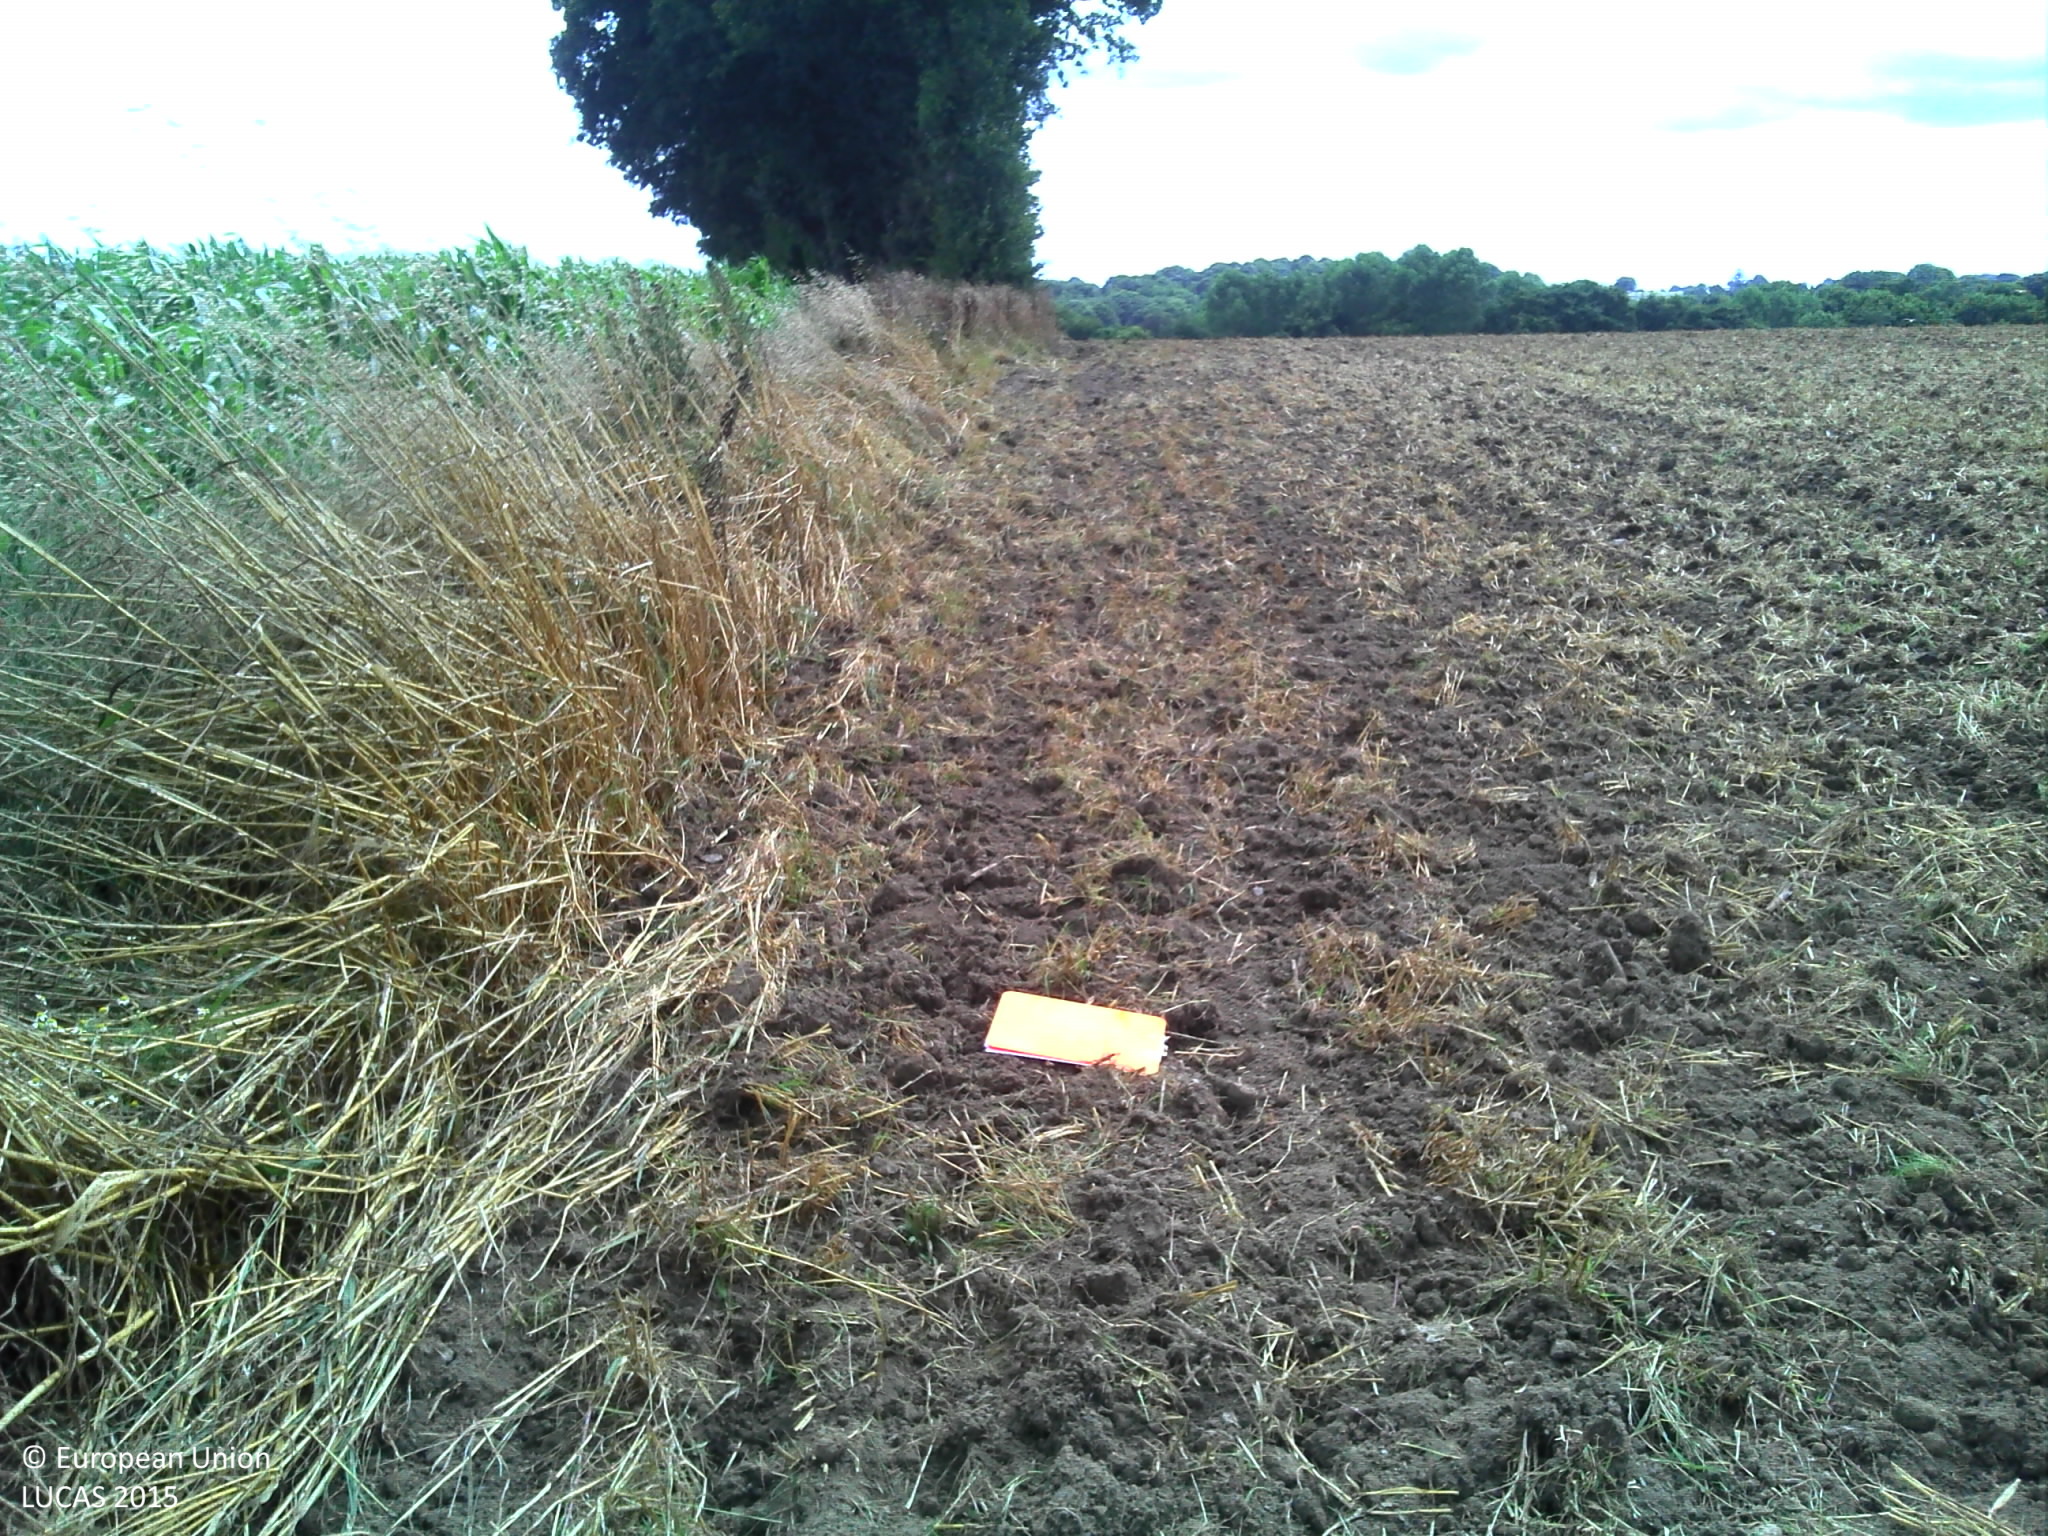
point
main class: Cropland
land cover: Maize
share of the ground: > 75 %
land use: Agriculture (excluding fallow land and kitchen gardens)
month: August
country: FR
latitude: 48.2954
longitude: -3.2429
